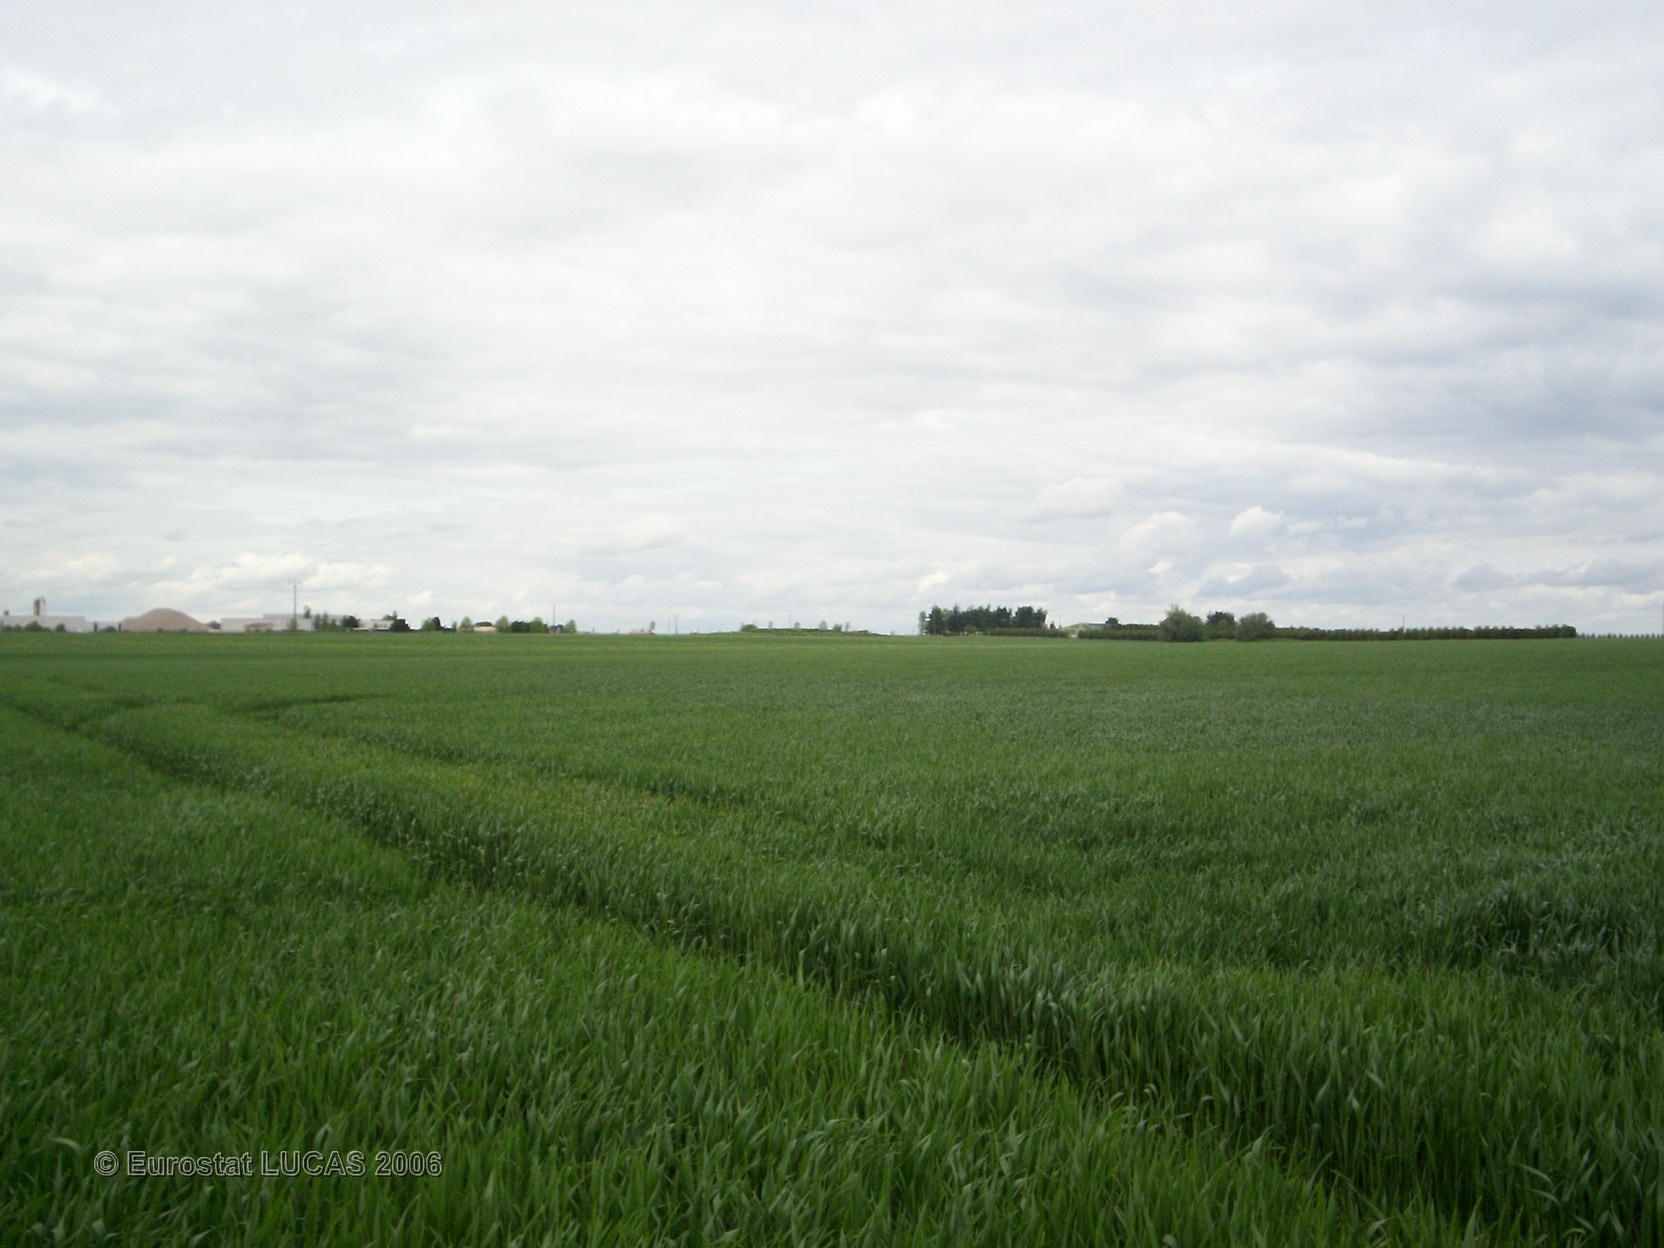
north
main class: Cropland
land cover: Common wheat
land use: Agriculture (excluding fallow land and kitchen gardens)
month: May
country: FR
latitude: 49.1060
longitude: 2.7710
